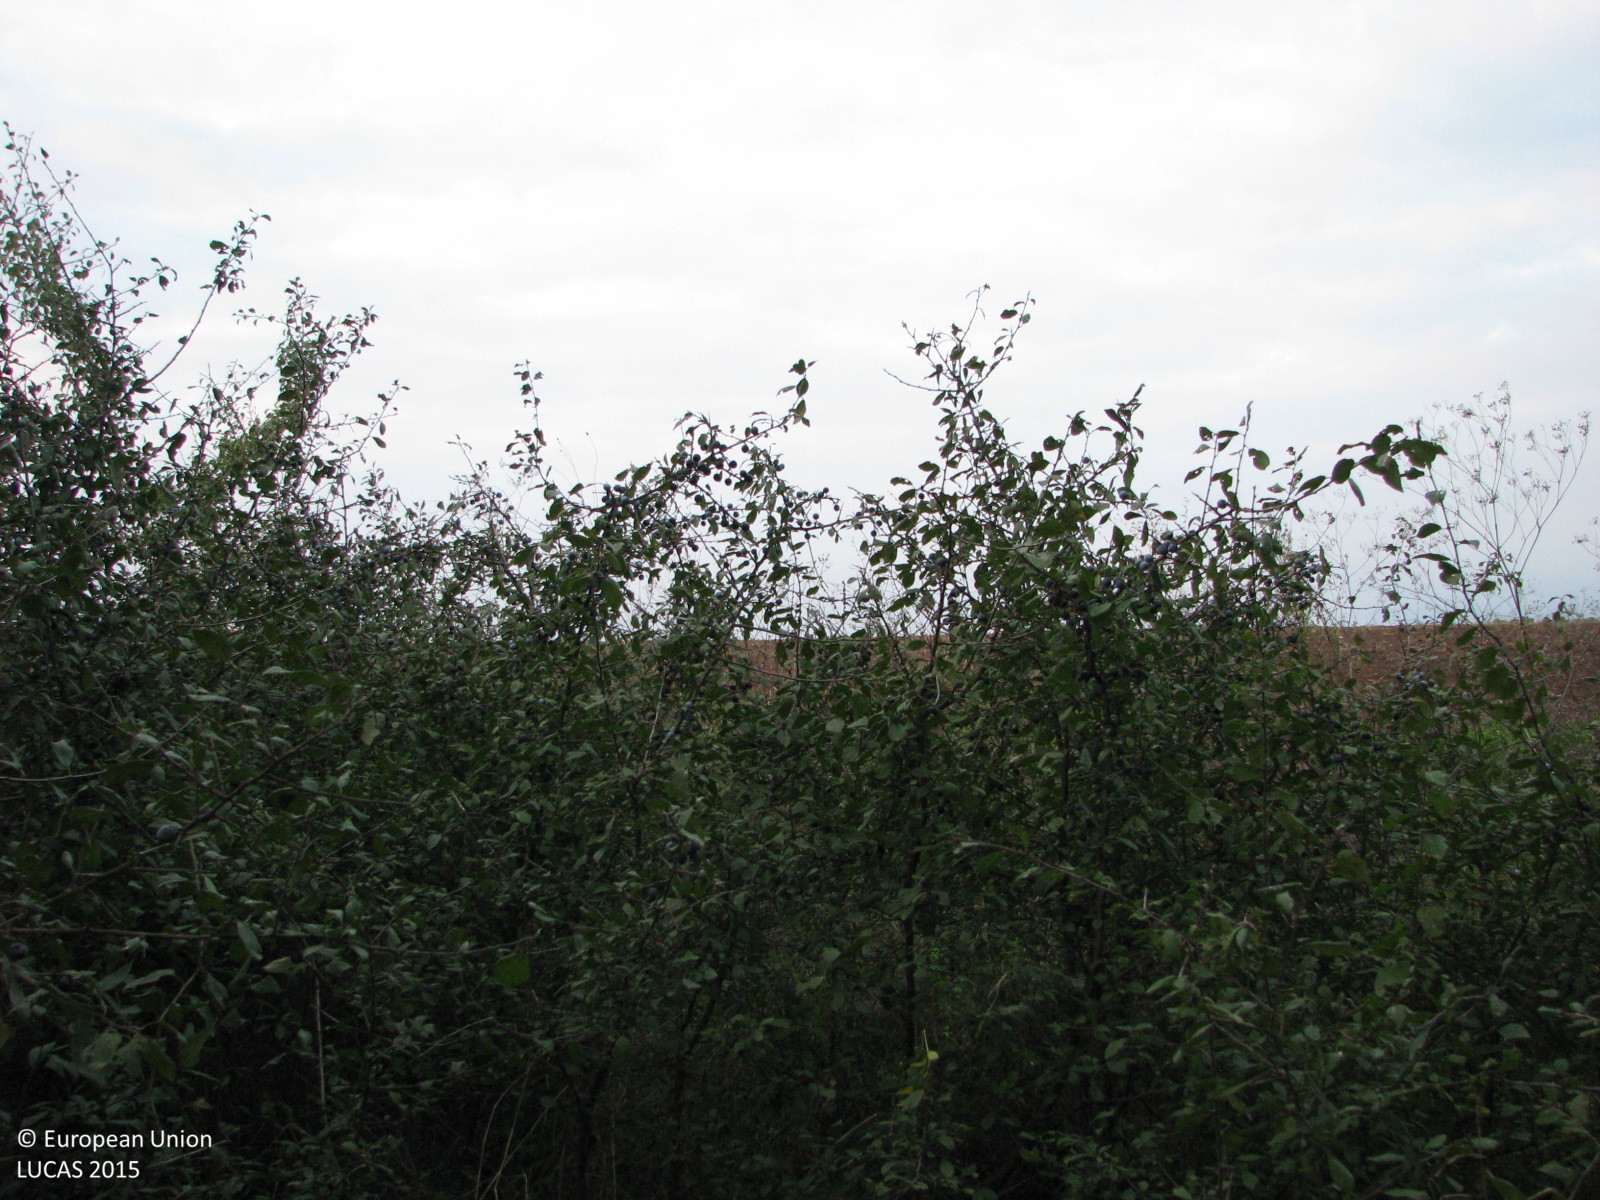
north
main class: Woodland
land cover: Broadleaved woodland
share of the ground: 10 - 25 %
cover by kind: herbaceous plants 65 %, broadleaved forest trees 20 %, shrubs 15 %
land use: Semi-natural and natural areas not in use
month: October
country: BG
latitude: 42.2791
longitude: 26.7442
